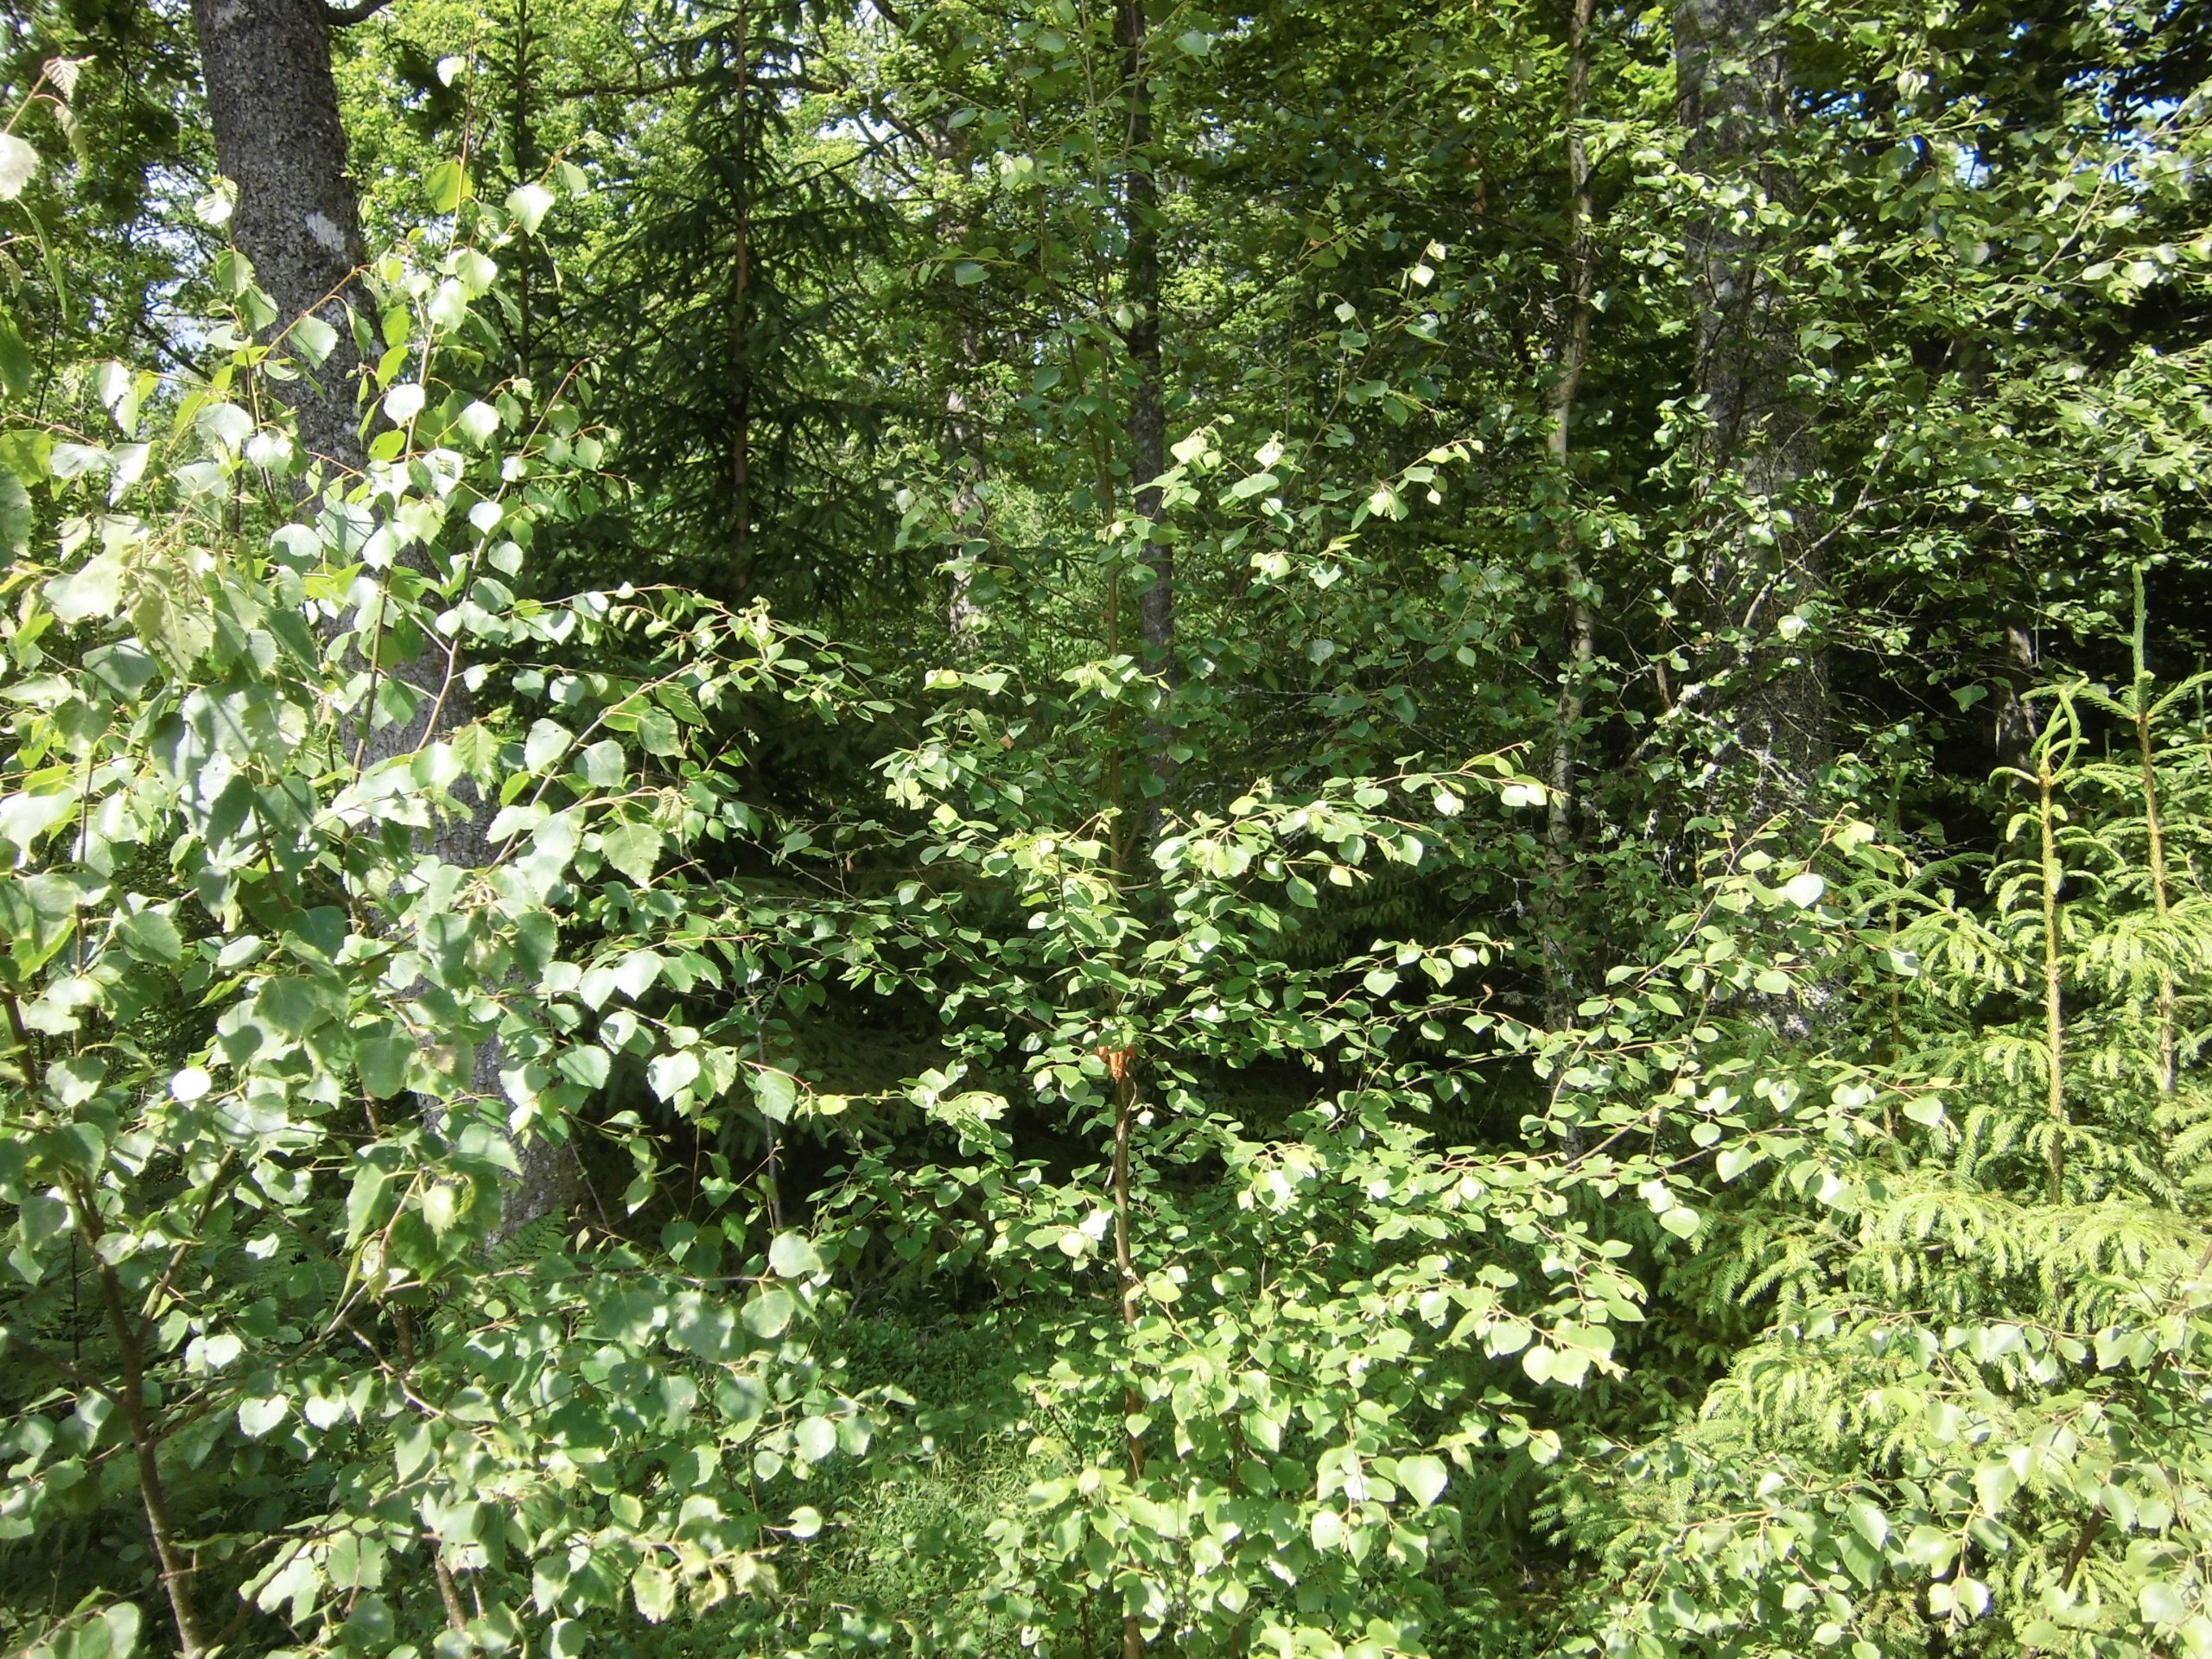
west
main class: Woodland
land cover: Broadleaved woodland
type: boreal forest
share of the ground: 50 - 75 %
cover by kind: broadleaved forest trees 55 %, herbaceous plants 20 %, coniferous forest trees 10 %, shrubs 10 %, lichens and mosses 5 %
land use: Forestry
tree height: > 5 m
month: June
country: SE
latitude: 56.9824
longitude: 14.7523
